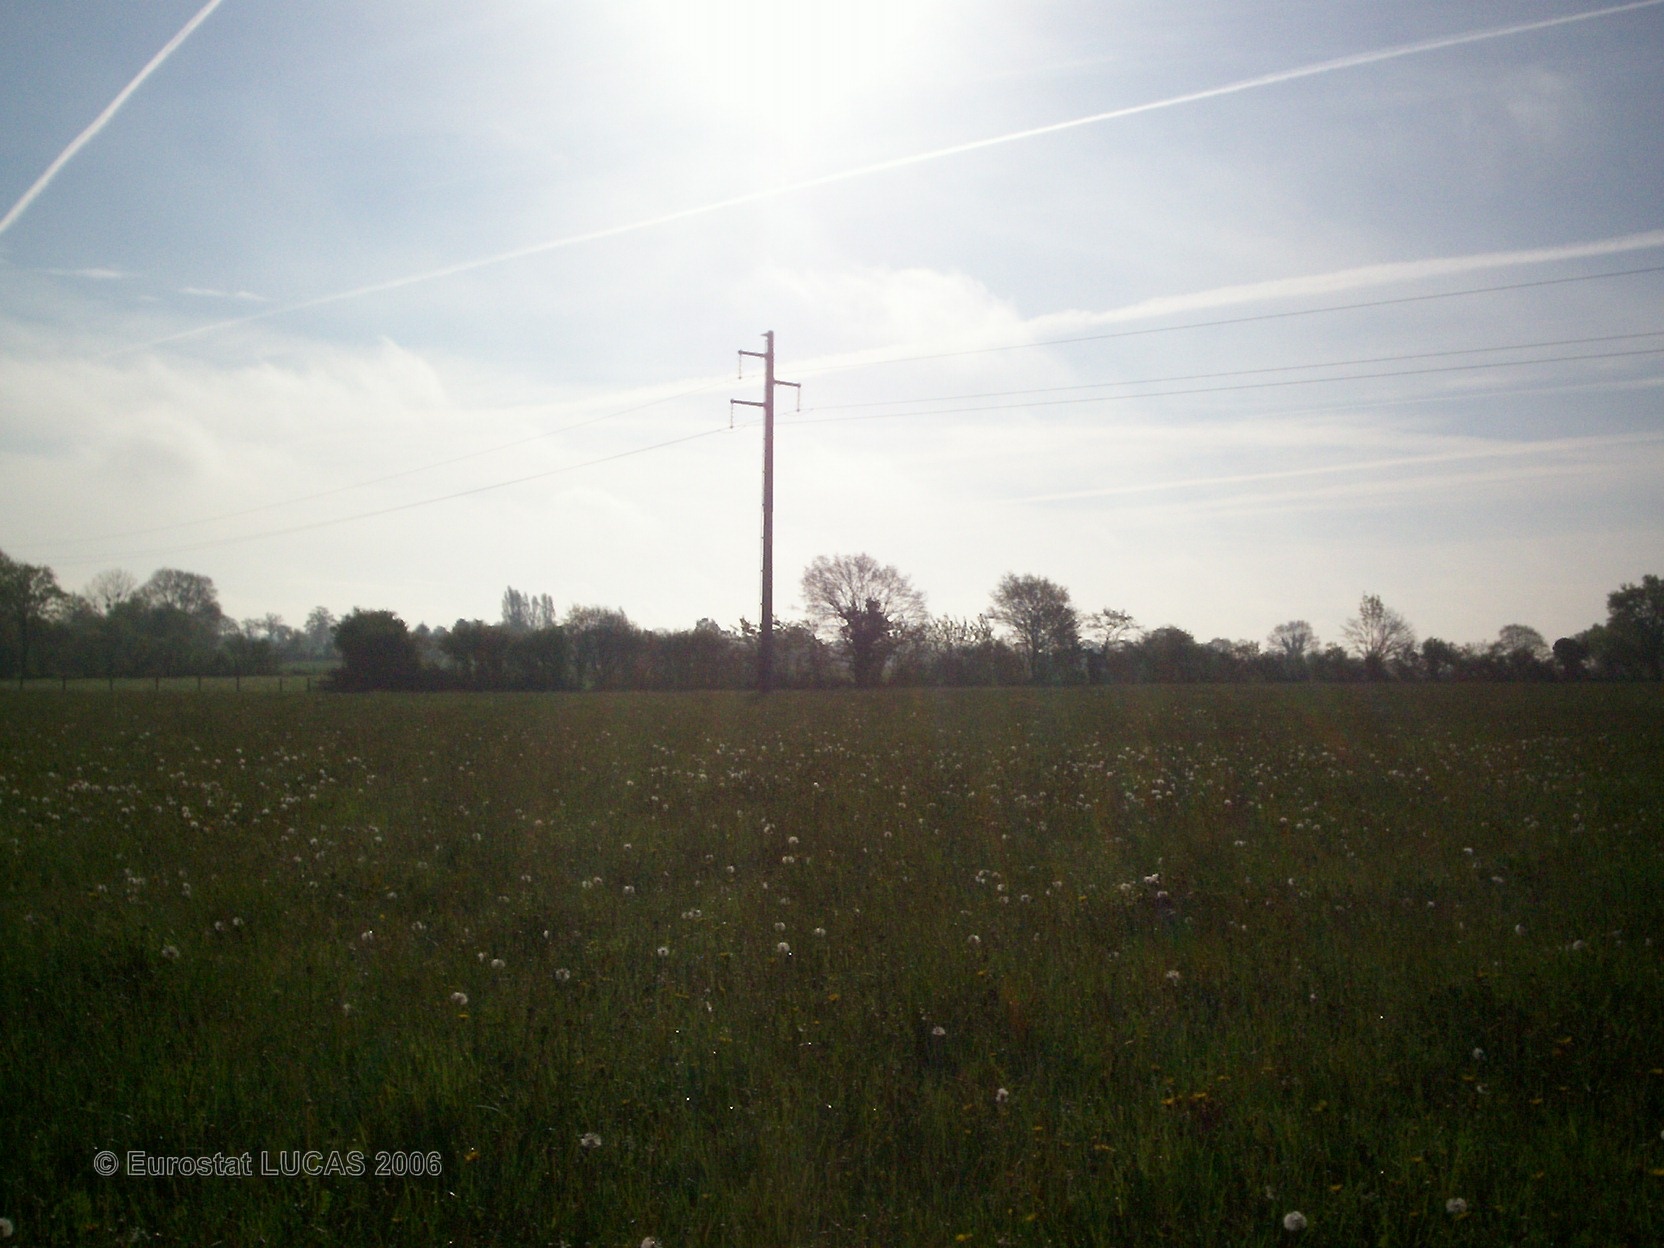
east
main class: Grassland
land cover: Grassland without tree/shrub cover
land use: Agriculture (excluding fallow land and kitchen gardens)
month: May
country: FR
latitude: 48.0716
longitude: -0.6240
